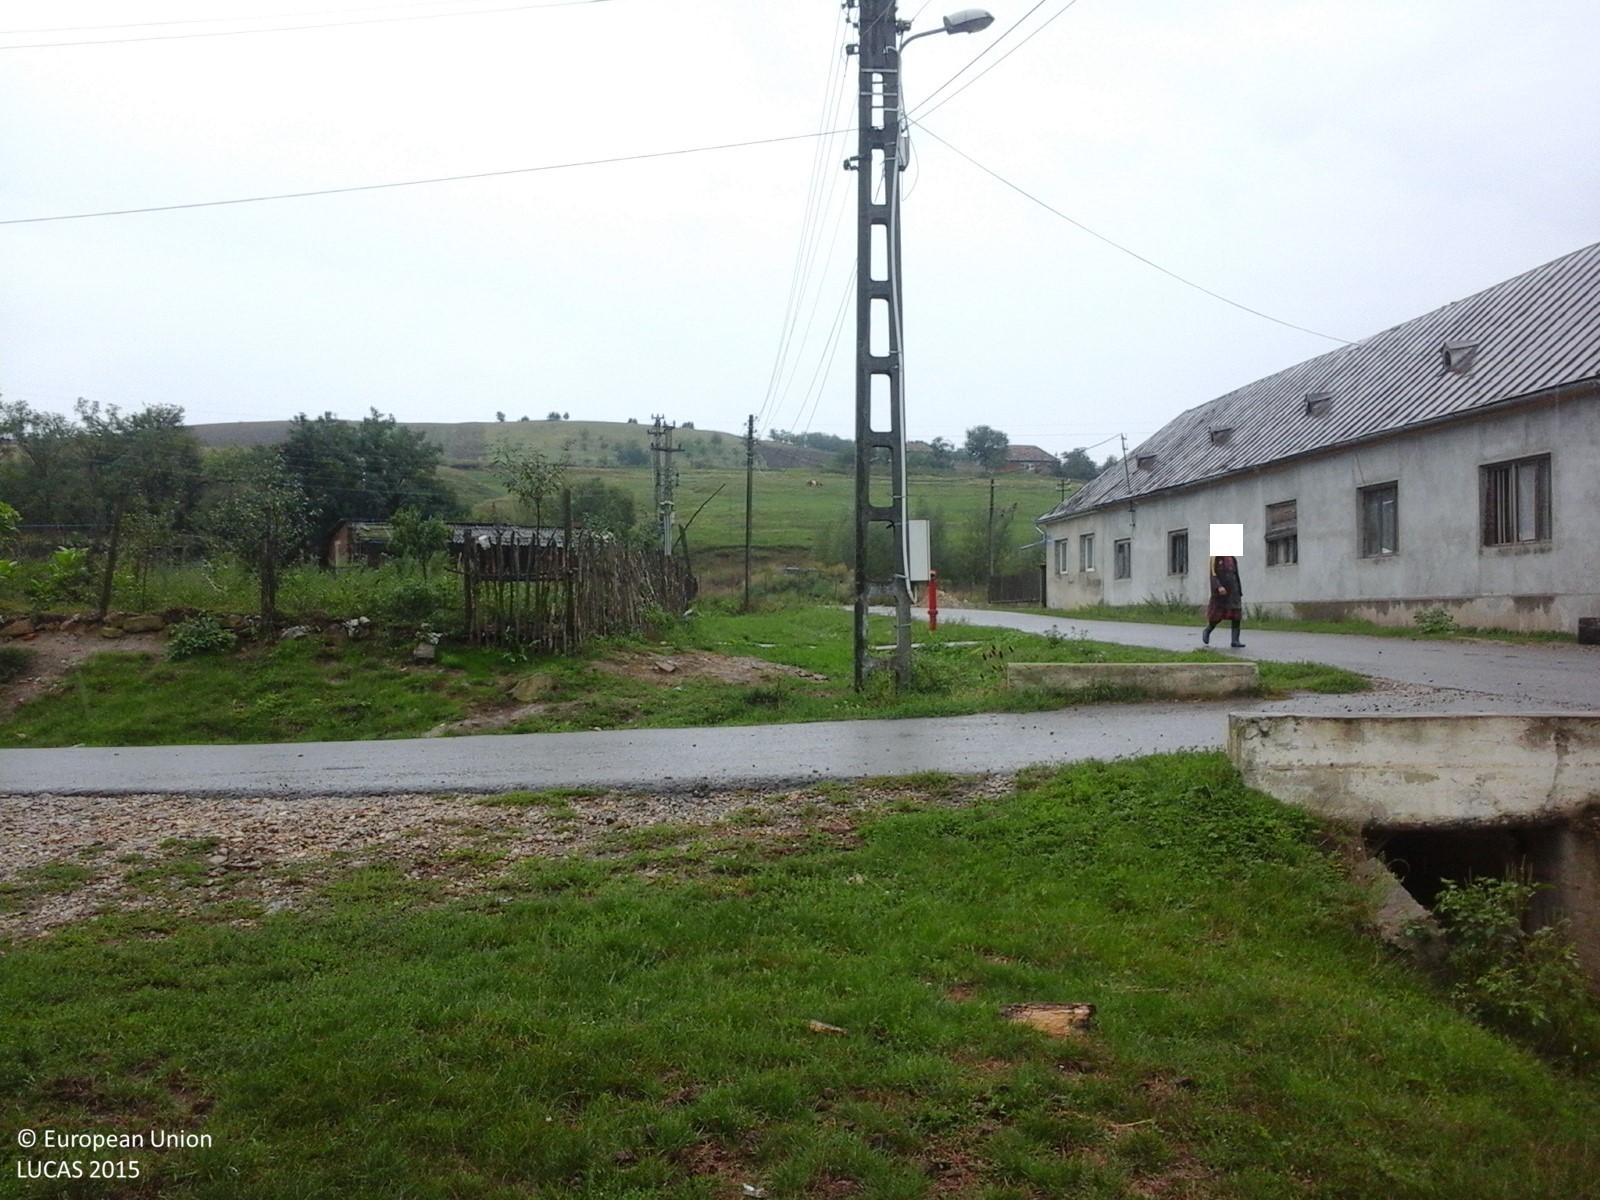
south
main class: Grassland
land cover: Grassland without tree/shrub cover
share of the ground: > 75 %
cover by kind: herbaceous plants 100 %
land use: Residential
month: September
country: RO
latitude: 47.3172
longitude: 22.4244
